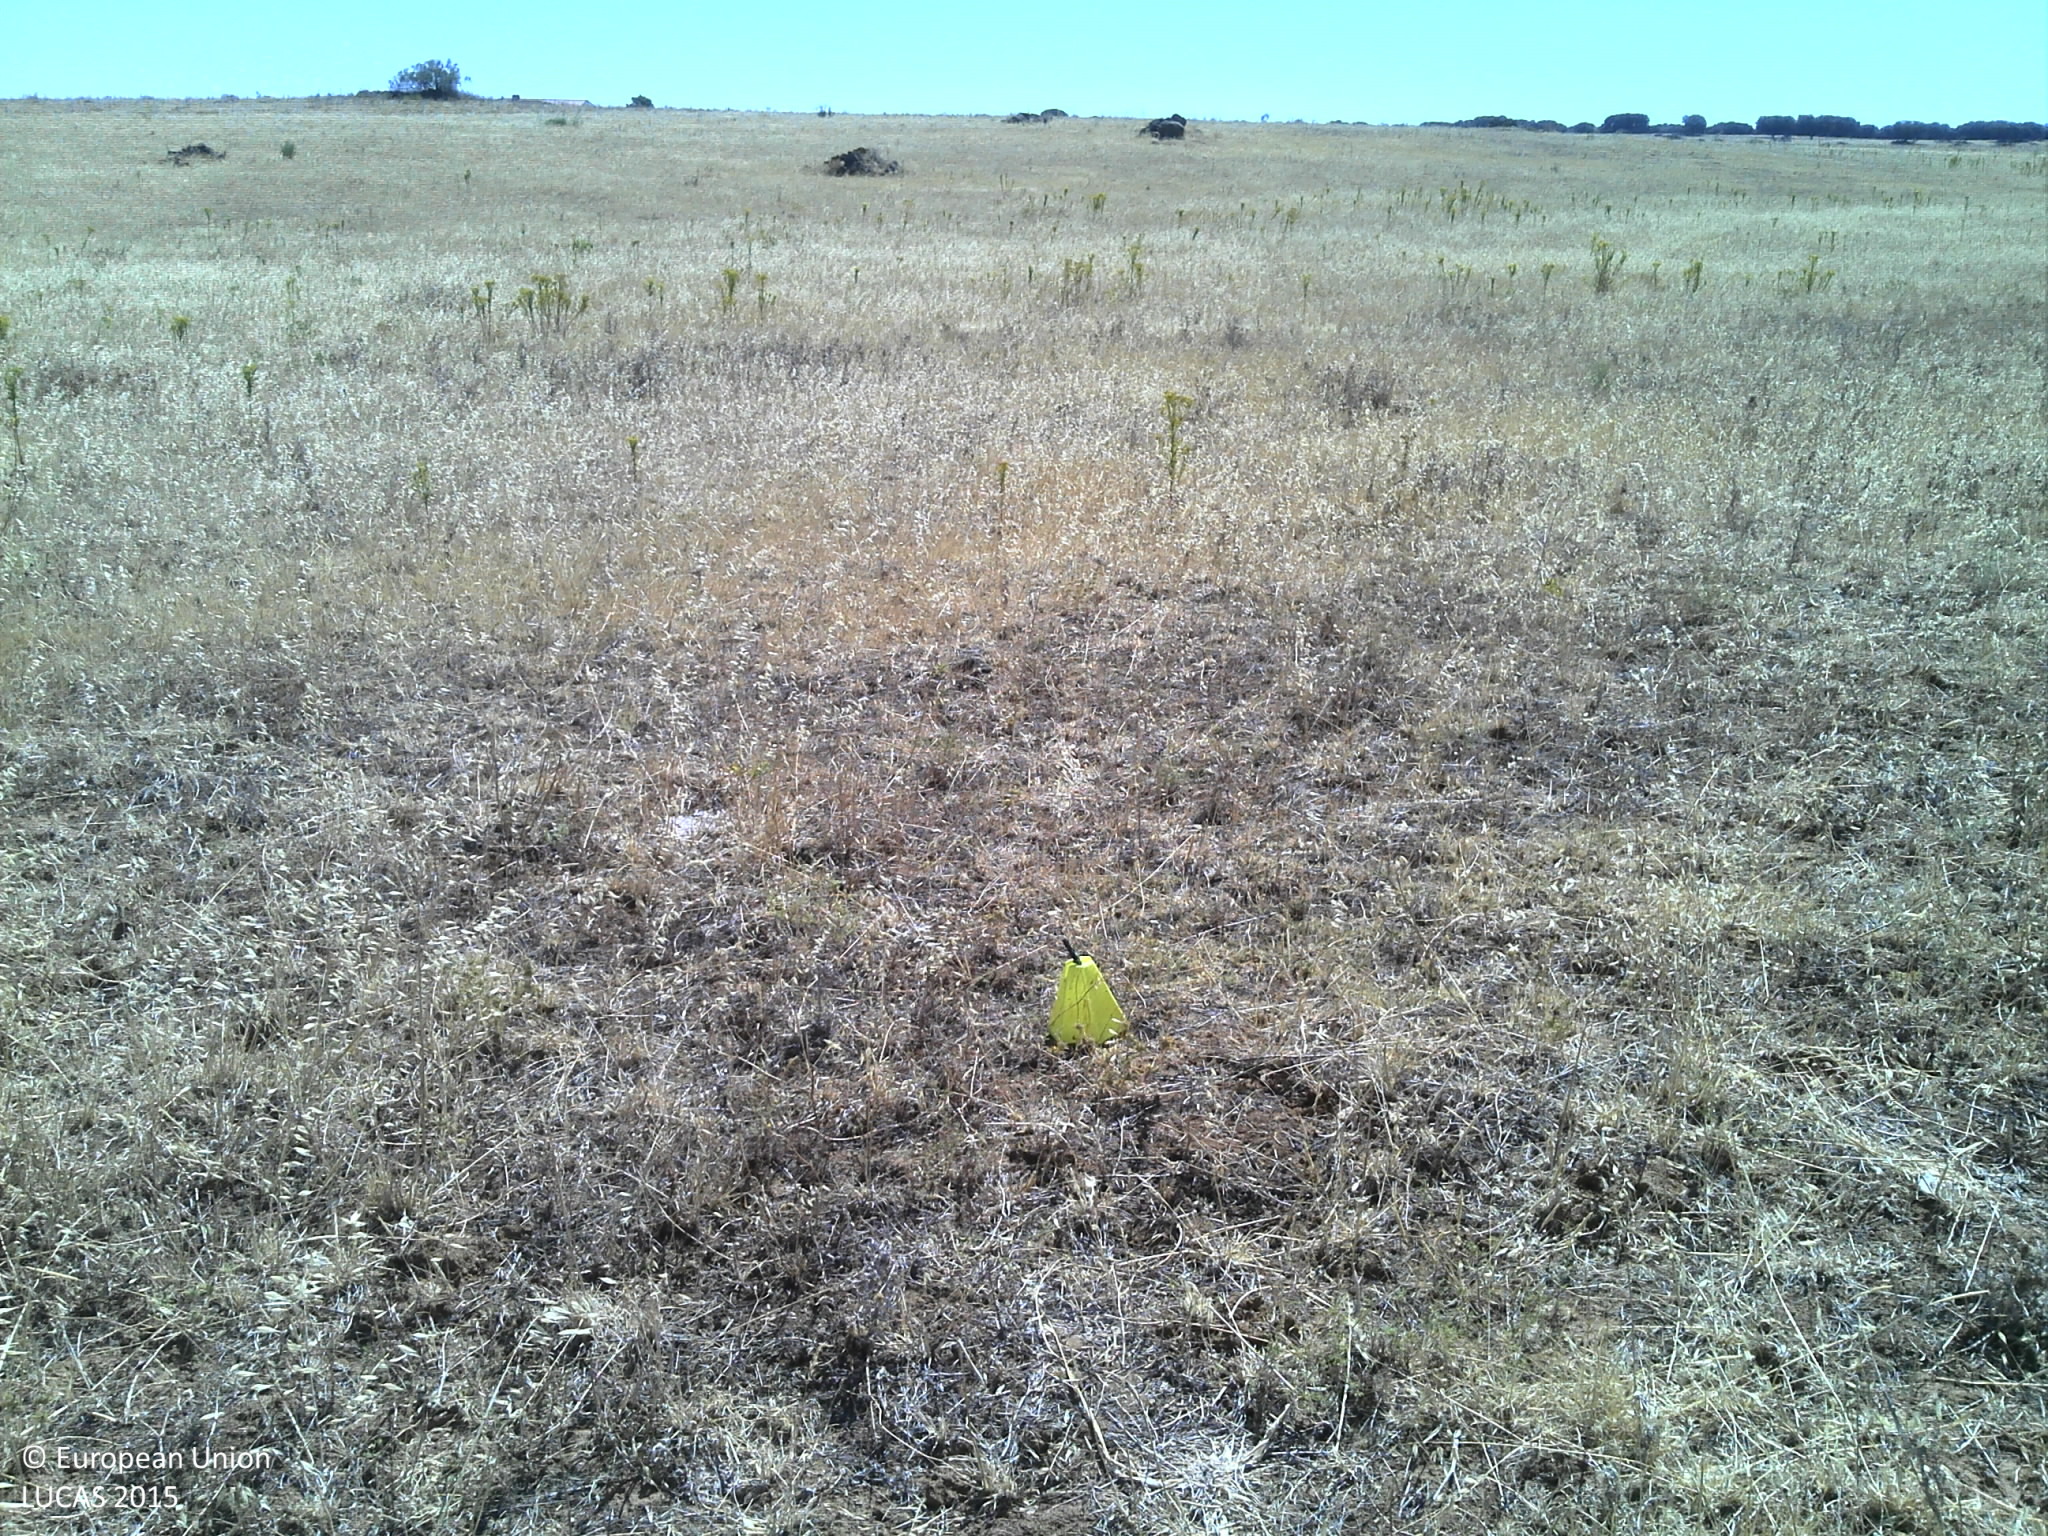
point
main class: Grassland
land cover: Grassland without tree/shrub cover
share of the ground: 10 - 25 %
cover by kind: unconsolidated bare surface 85 %, herbaceous plants 15 %
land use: Agriculture (excluding fallow land and kitchen gardens)
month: July
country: PT
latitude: 38.9600
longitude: -7.2847
